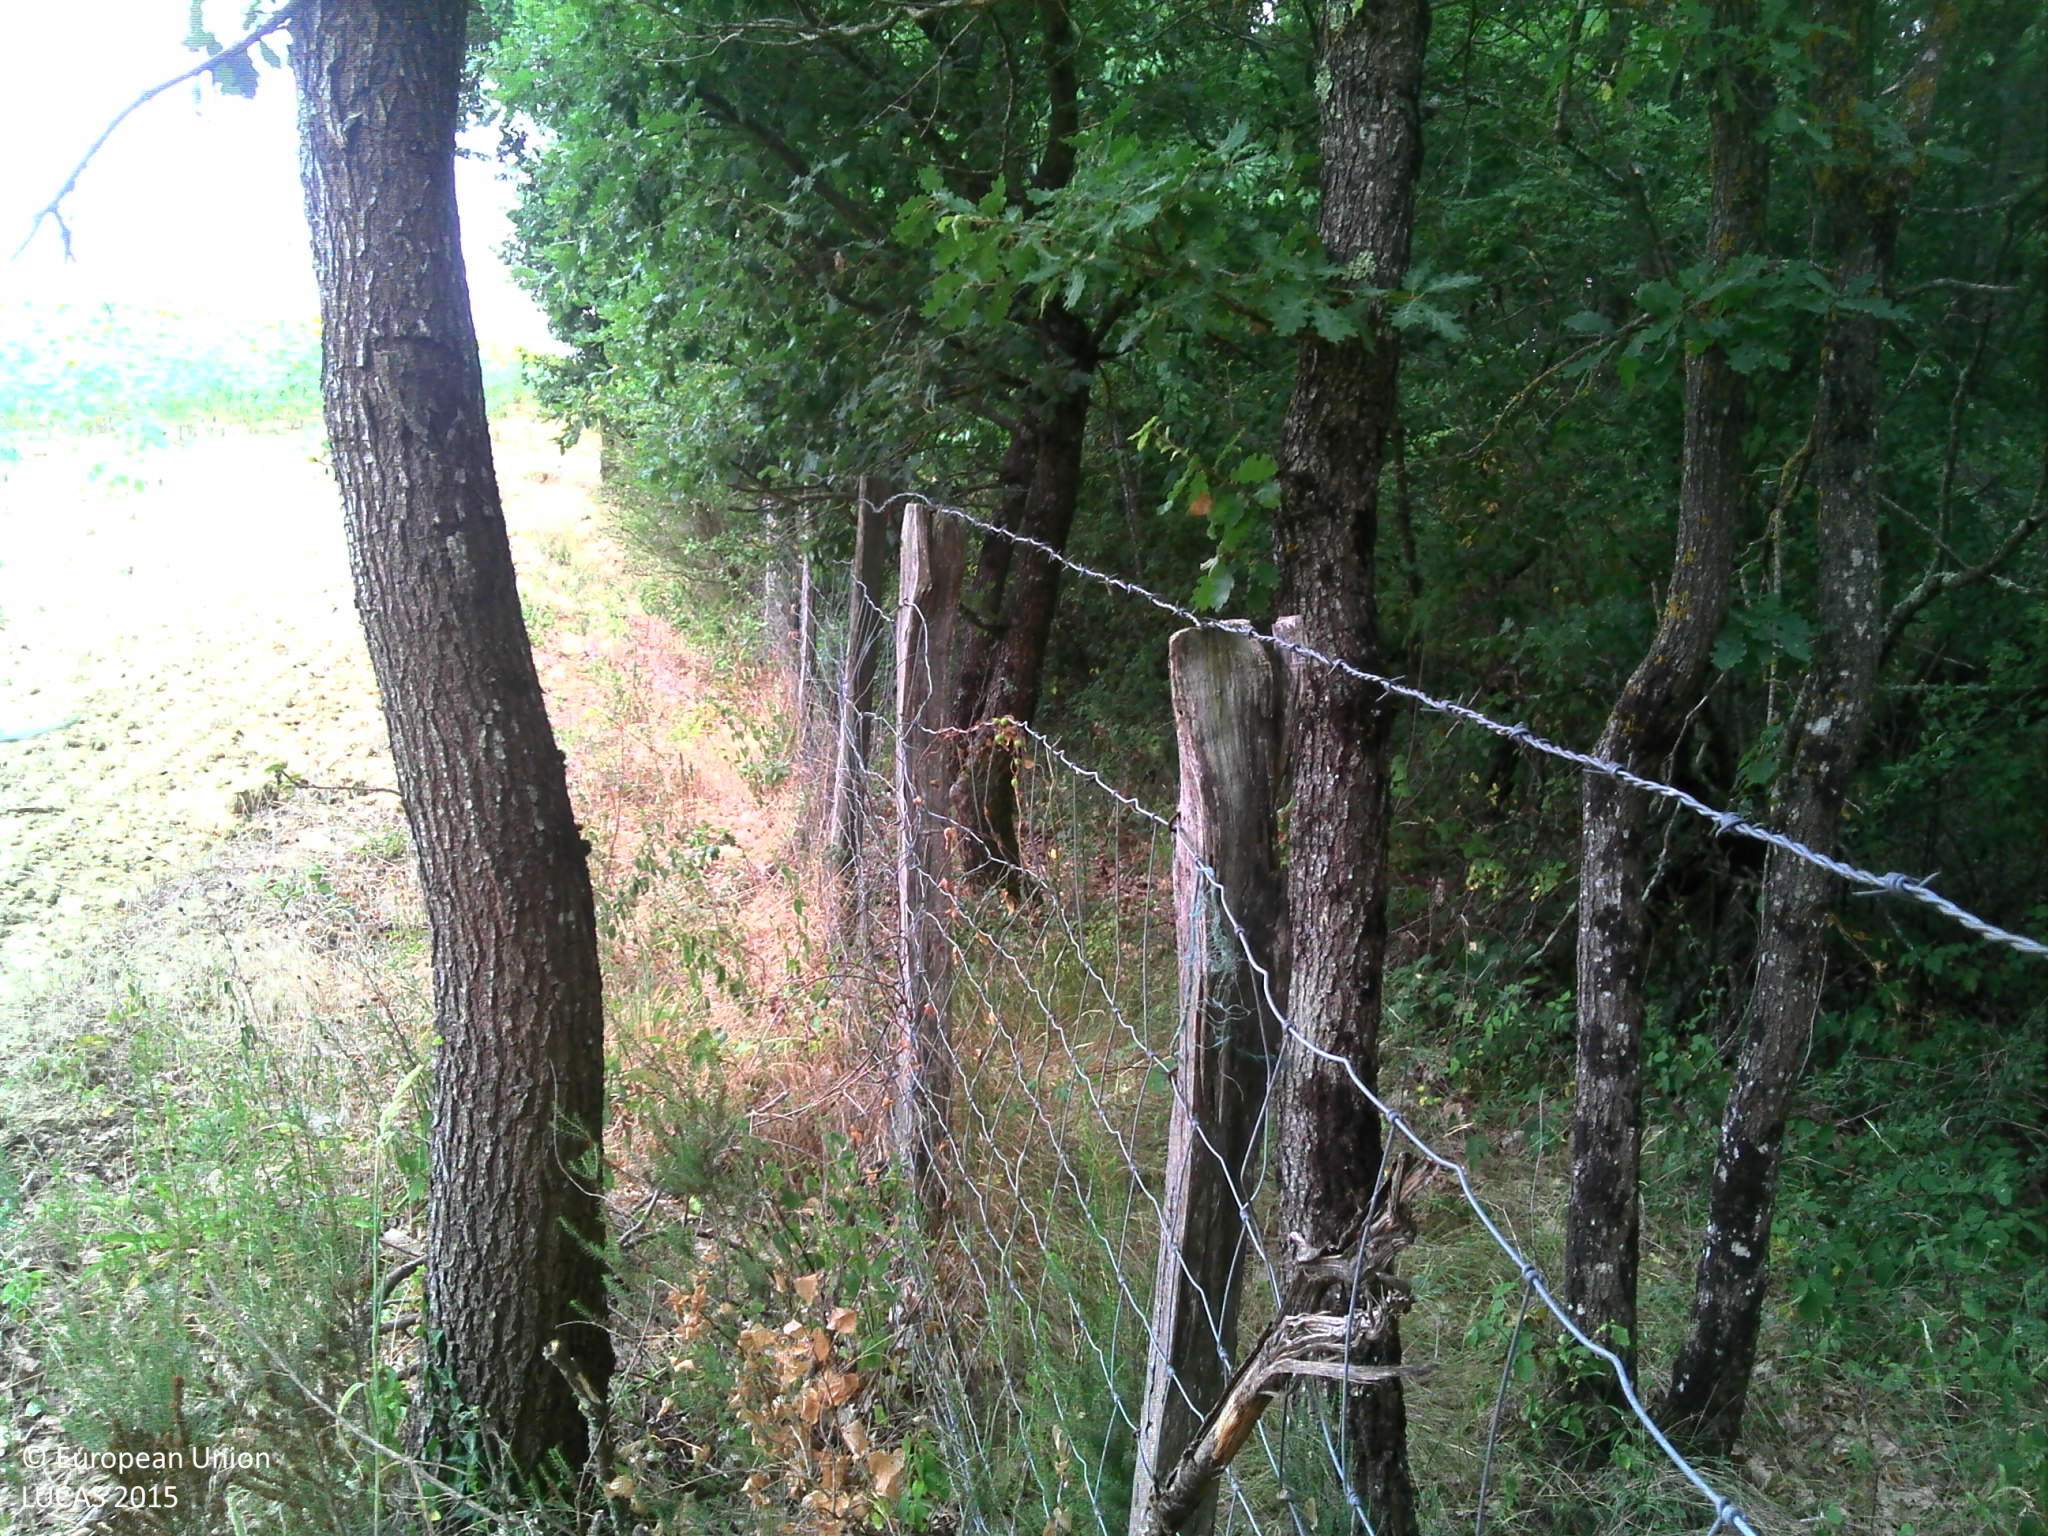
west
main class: Woodland
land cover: Broadleaved woodland
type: mesophytic deciduous forest
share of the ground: > 75 %
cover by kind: broadleaved forest trees 100 %
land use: Forestry
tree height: > 5 m
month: July
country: FR
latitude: 43.9713
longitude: 0.9359
